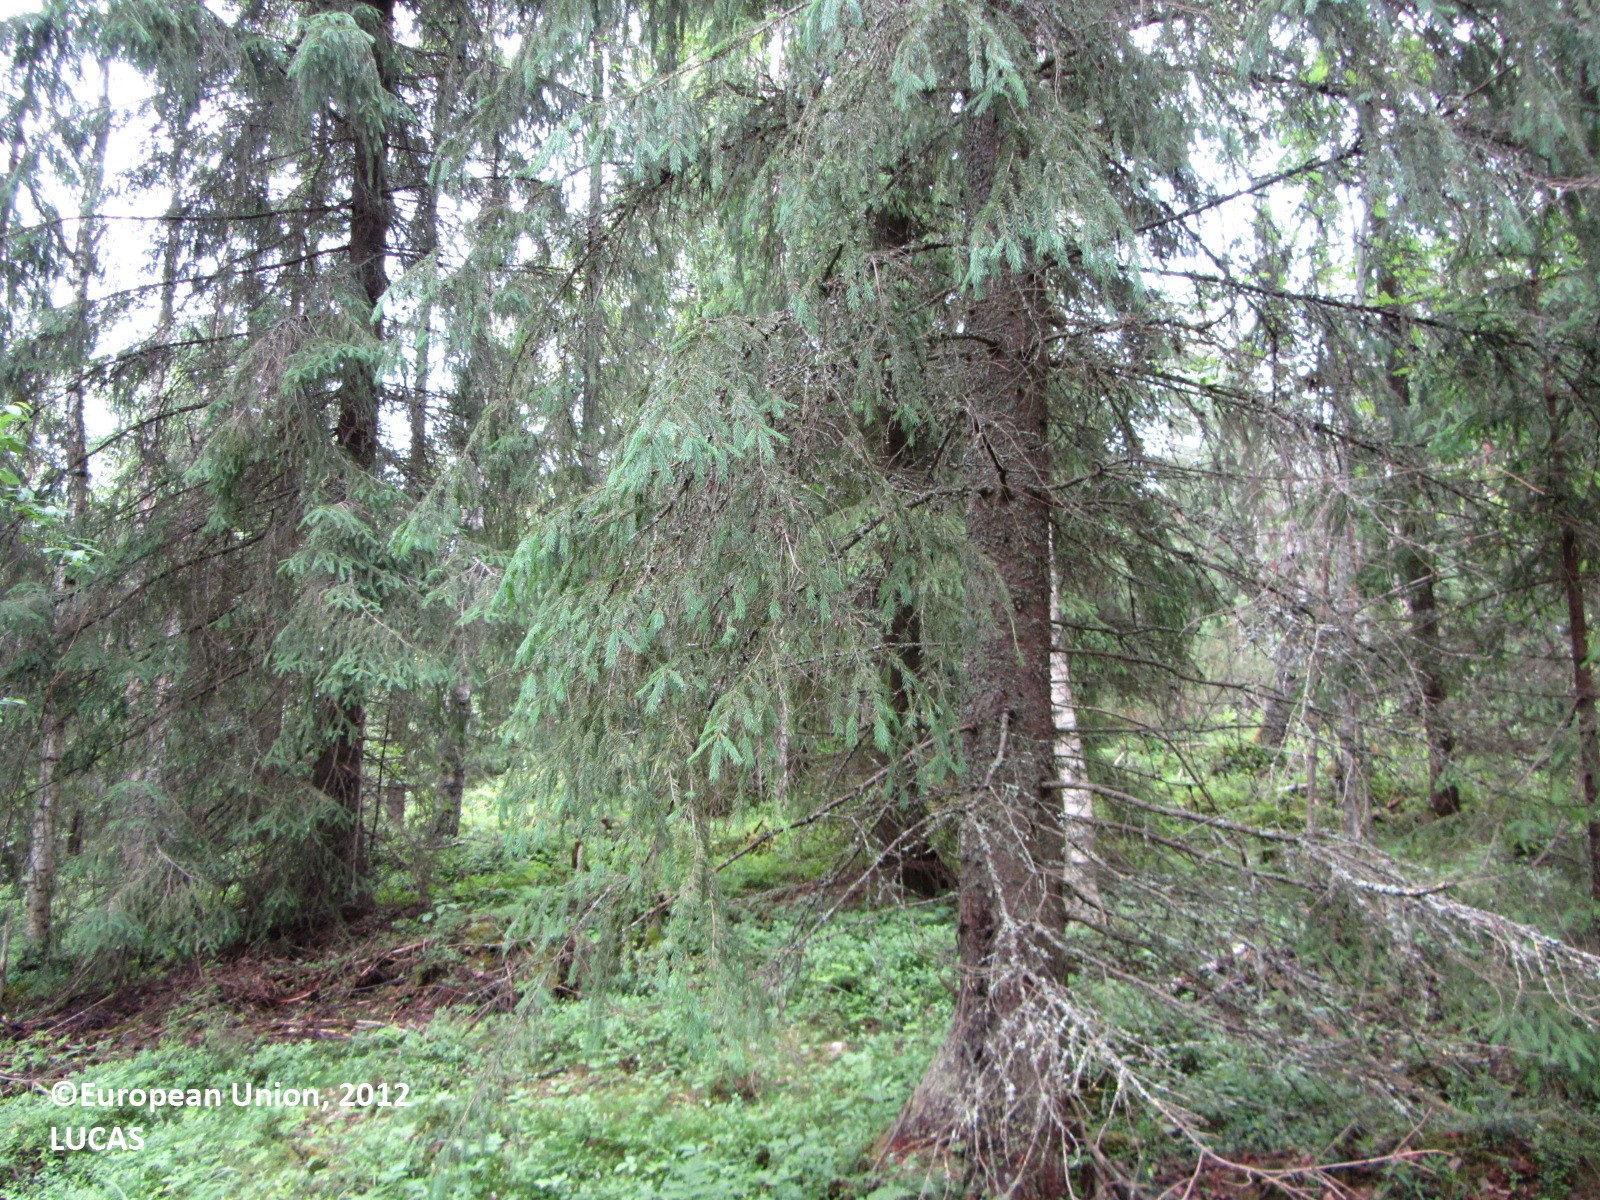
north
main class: Woodland
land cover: Spruce dominated mixed woodland
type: boreal forest
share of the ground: 50 - 75 %
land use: Forestry
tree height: > 5 m
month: July
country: FI
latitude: 62.9367
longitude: 25.0502
